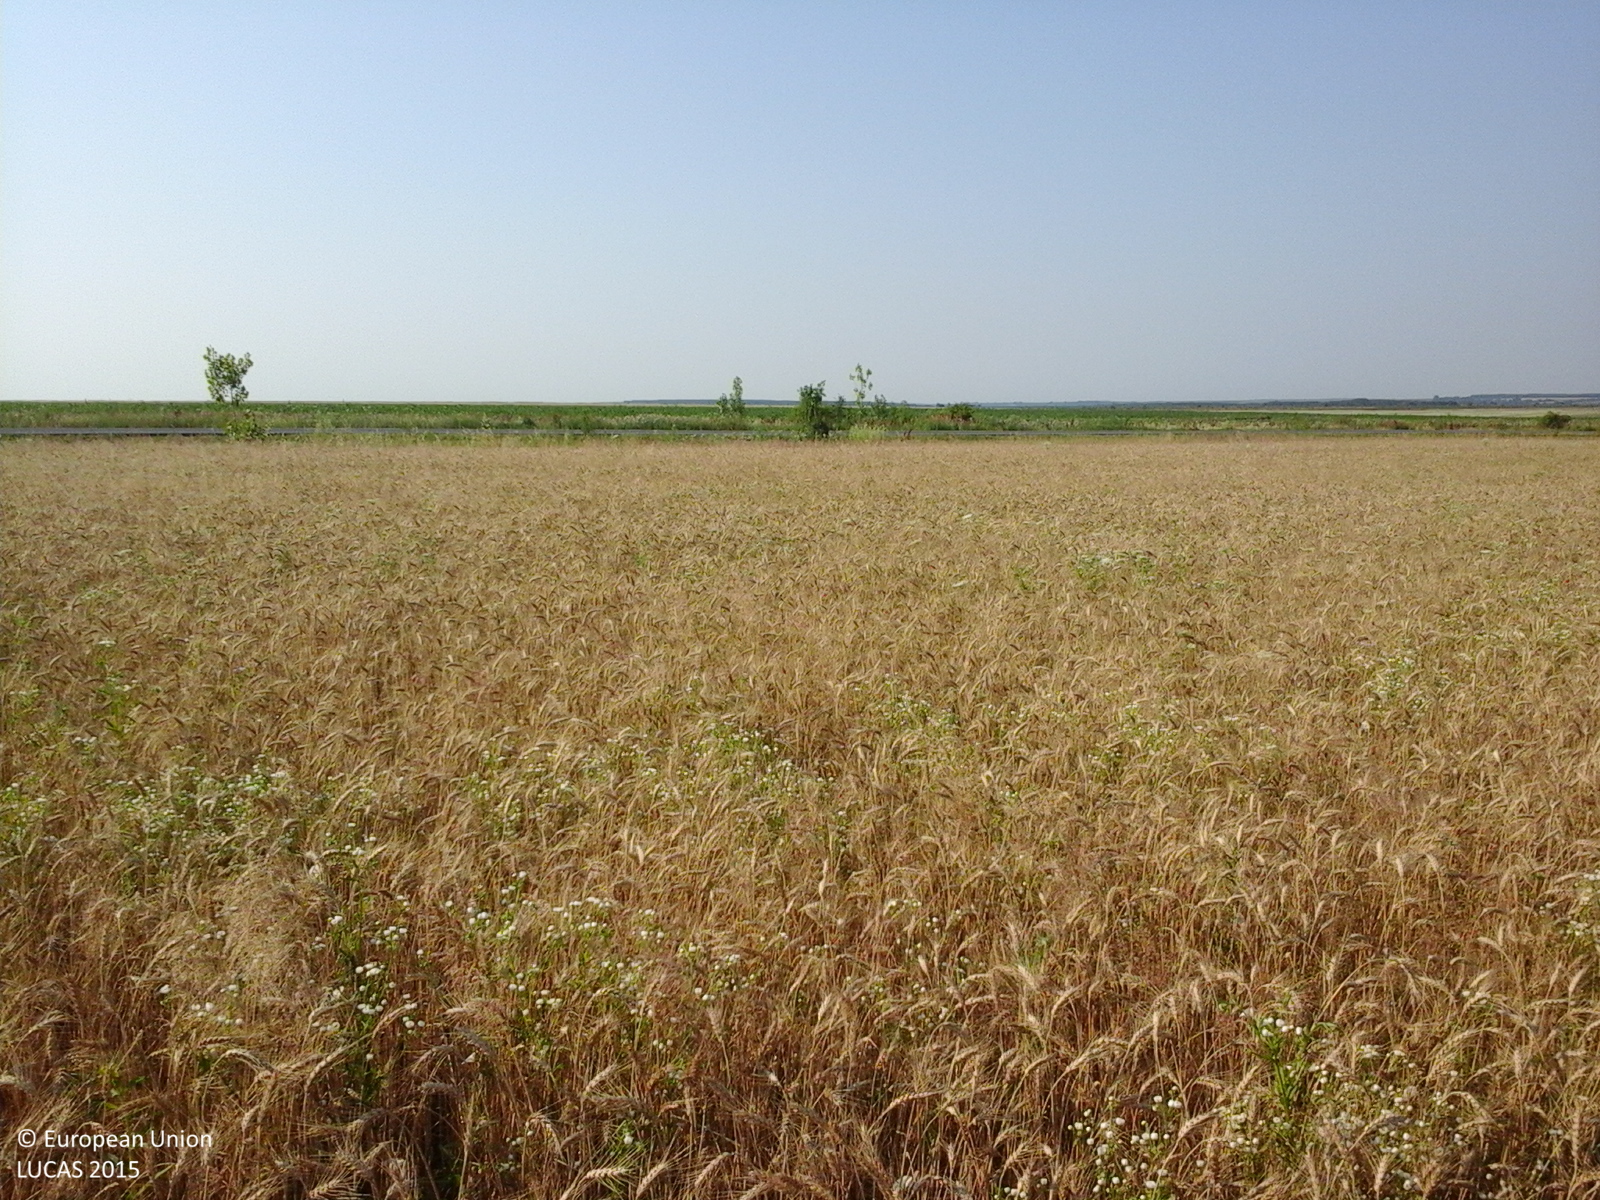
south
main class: Cropland
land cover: Common wheat
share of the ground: > 75 %
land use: Agriculture (excluding fallow land and kitchen gardens)
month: July
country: RO
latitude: 44.6212
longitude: 24.6570
